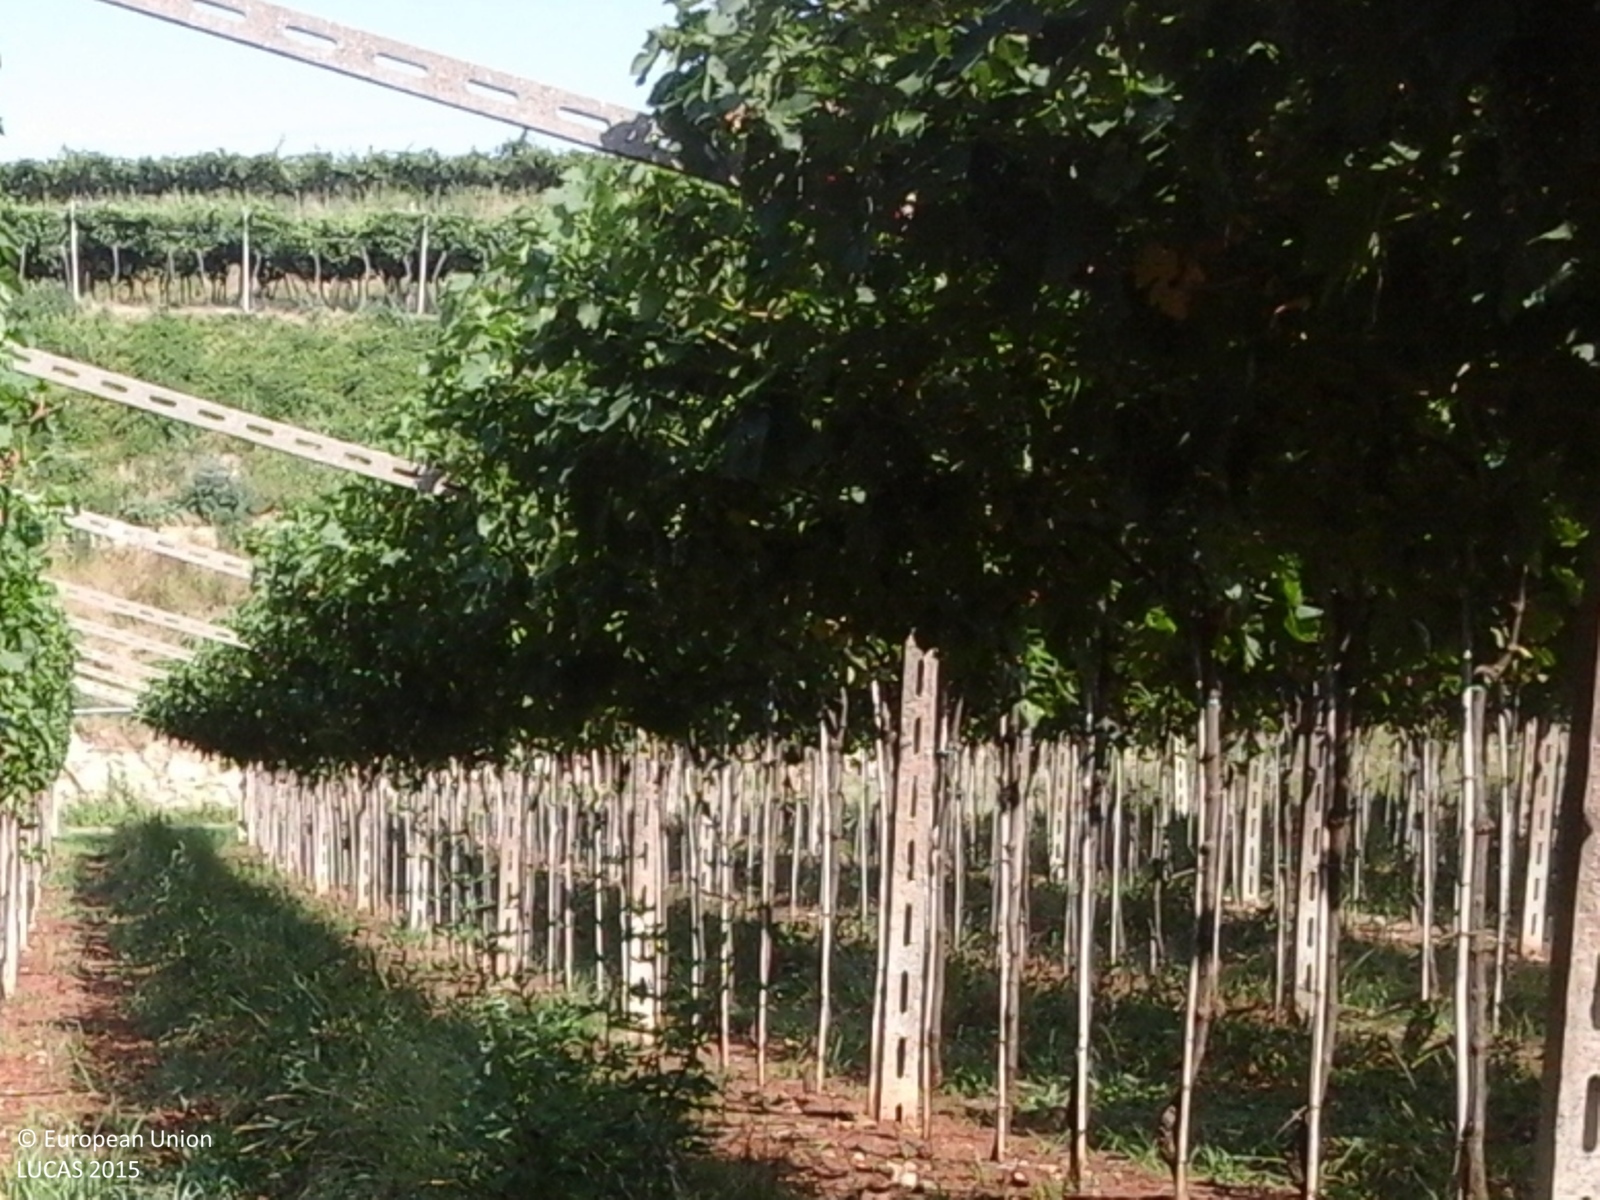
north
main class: Cropland
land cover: Vineyards
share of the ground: > 75 %
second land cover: Grassland without tree/shrub cover
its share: > 75 %
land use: Agriculture (excluding fallow land and kitchen gardens)
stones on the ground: < 10 %
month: July
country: IT
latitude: 45.5001
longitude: 10.9582
